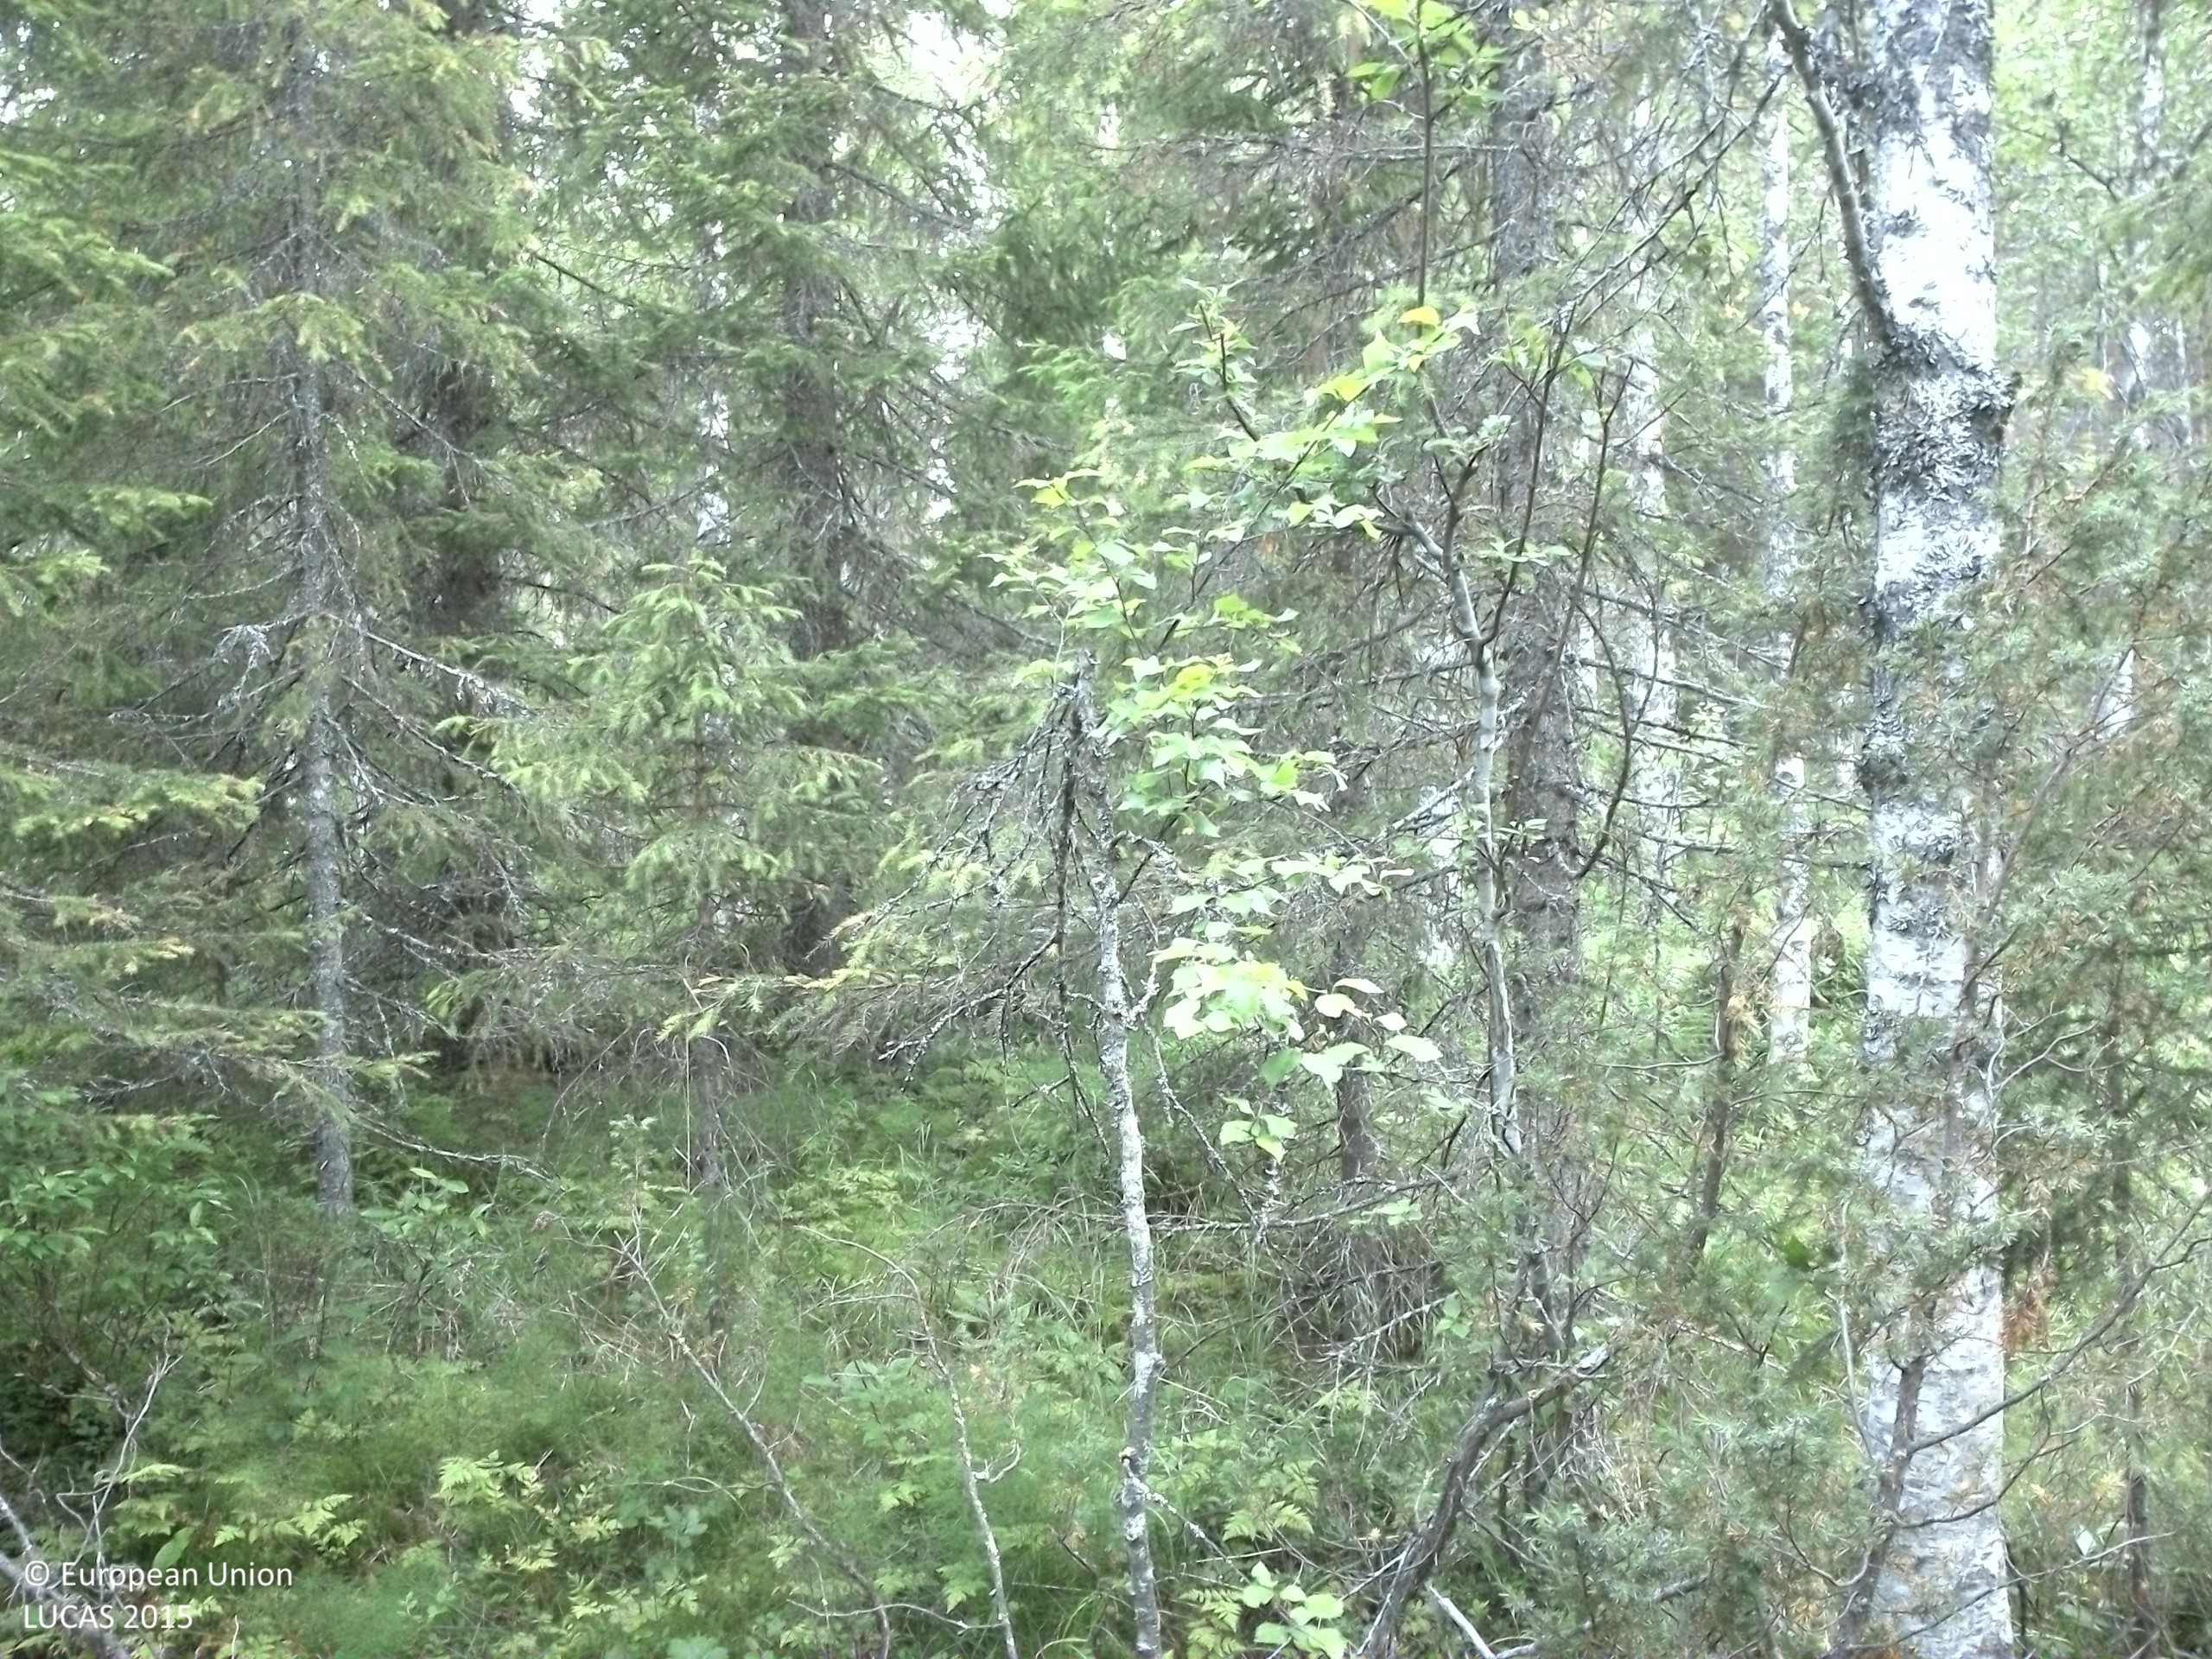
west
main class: Woodland
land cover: Spruce dominated mixed woodland
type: boreal forest
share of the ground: > 75 %
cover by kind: coniferous forest trees 45 %, shrubs 25 %, broadleaved forest trees 20 %, herbaceous plants 10 %
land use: Forestry
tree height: > 5 m
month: August
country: SE
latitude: 63.8212
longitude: 17.8753
